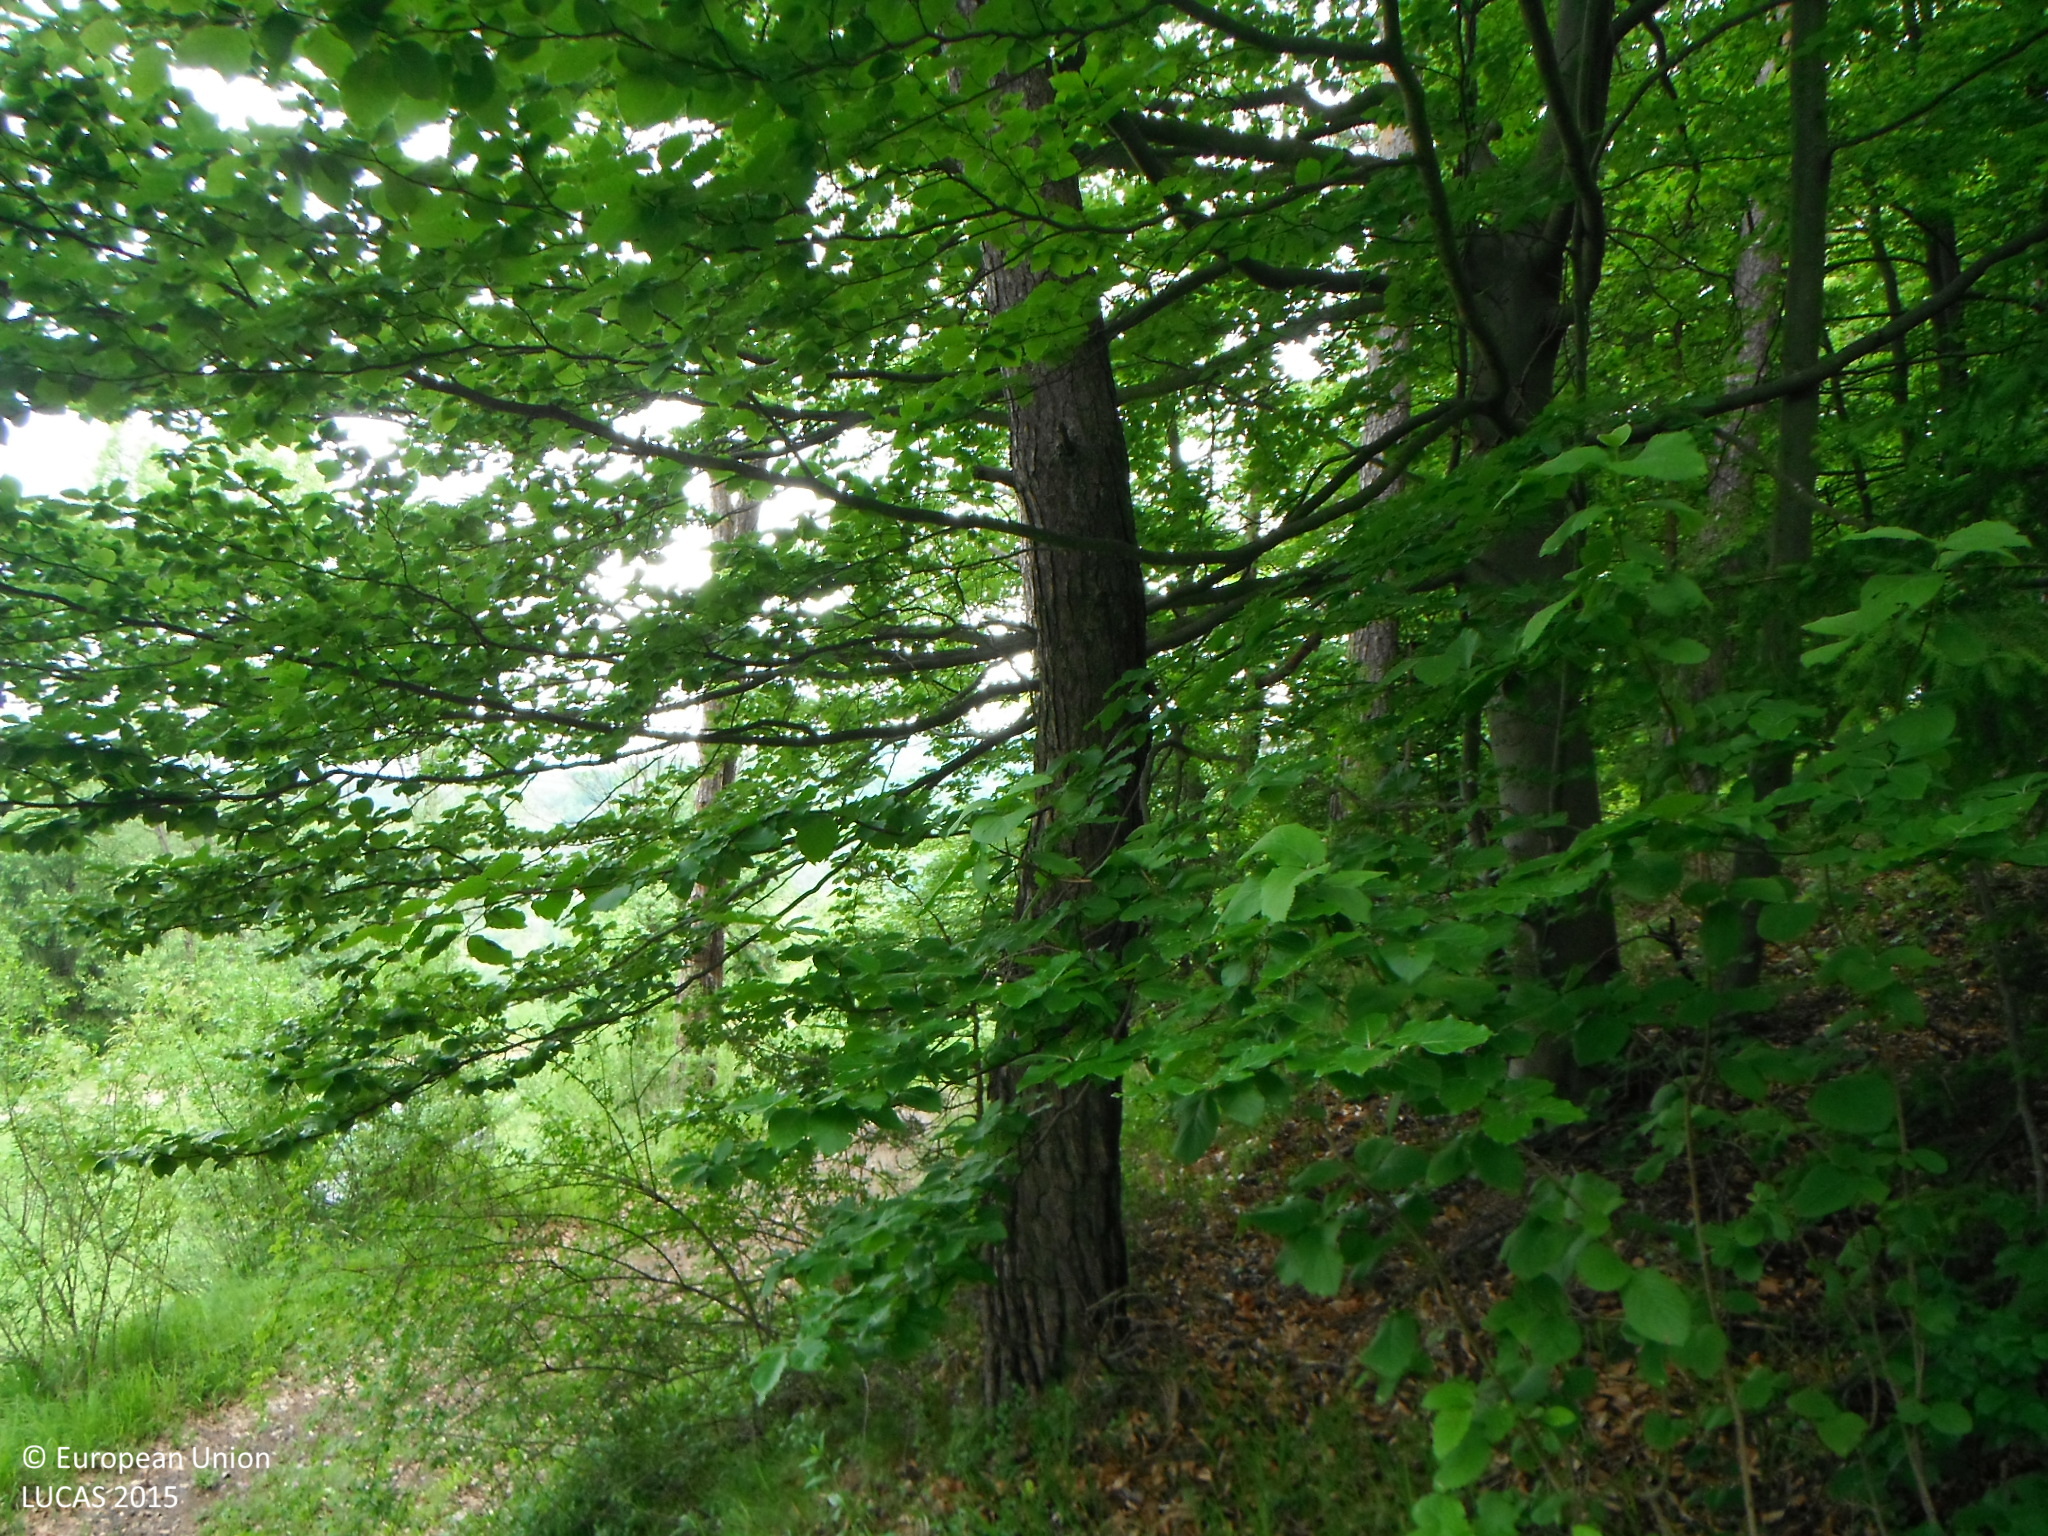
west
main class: Woodland
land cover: Pine dominated mixed woodland
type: hemiboreal forest and nemoral coniferous forest and mixed broadleaved-coniferous forest
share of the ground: > 75 %
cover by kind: coniferous forest trees 75 %, broadleaved forest trees 25 %
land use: Forestry
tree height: > 5 m
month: May
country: SK
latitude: 48.7790
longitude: 19.2087
